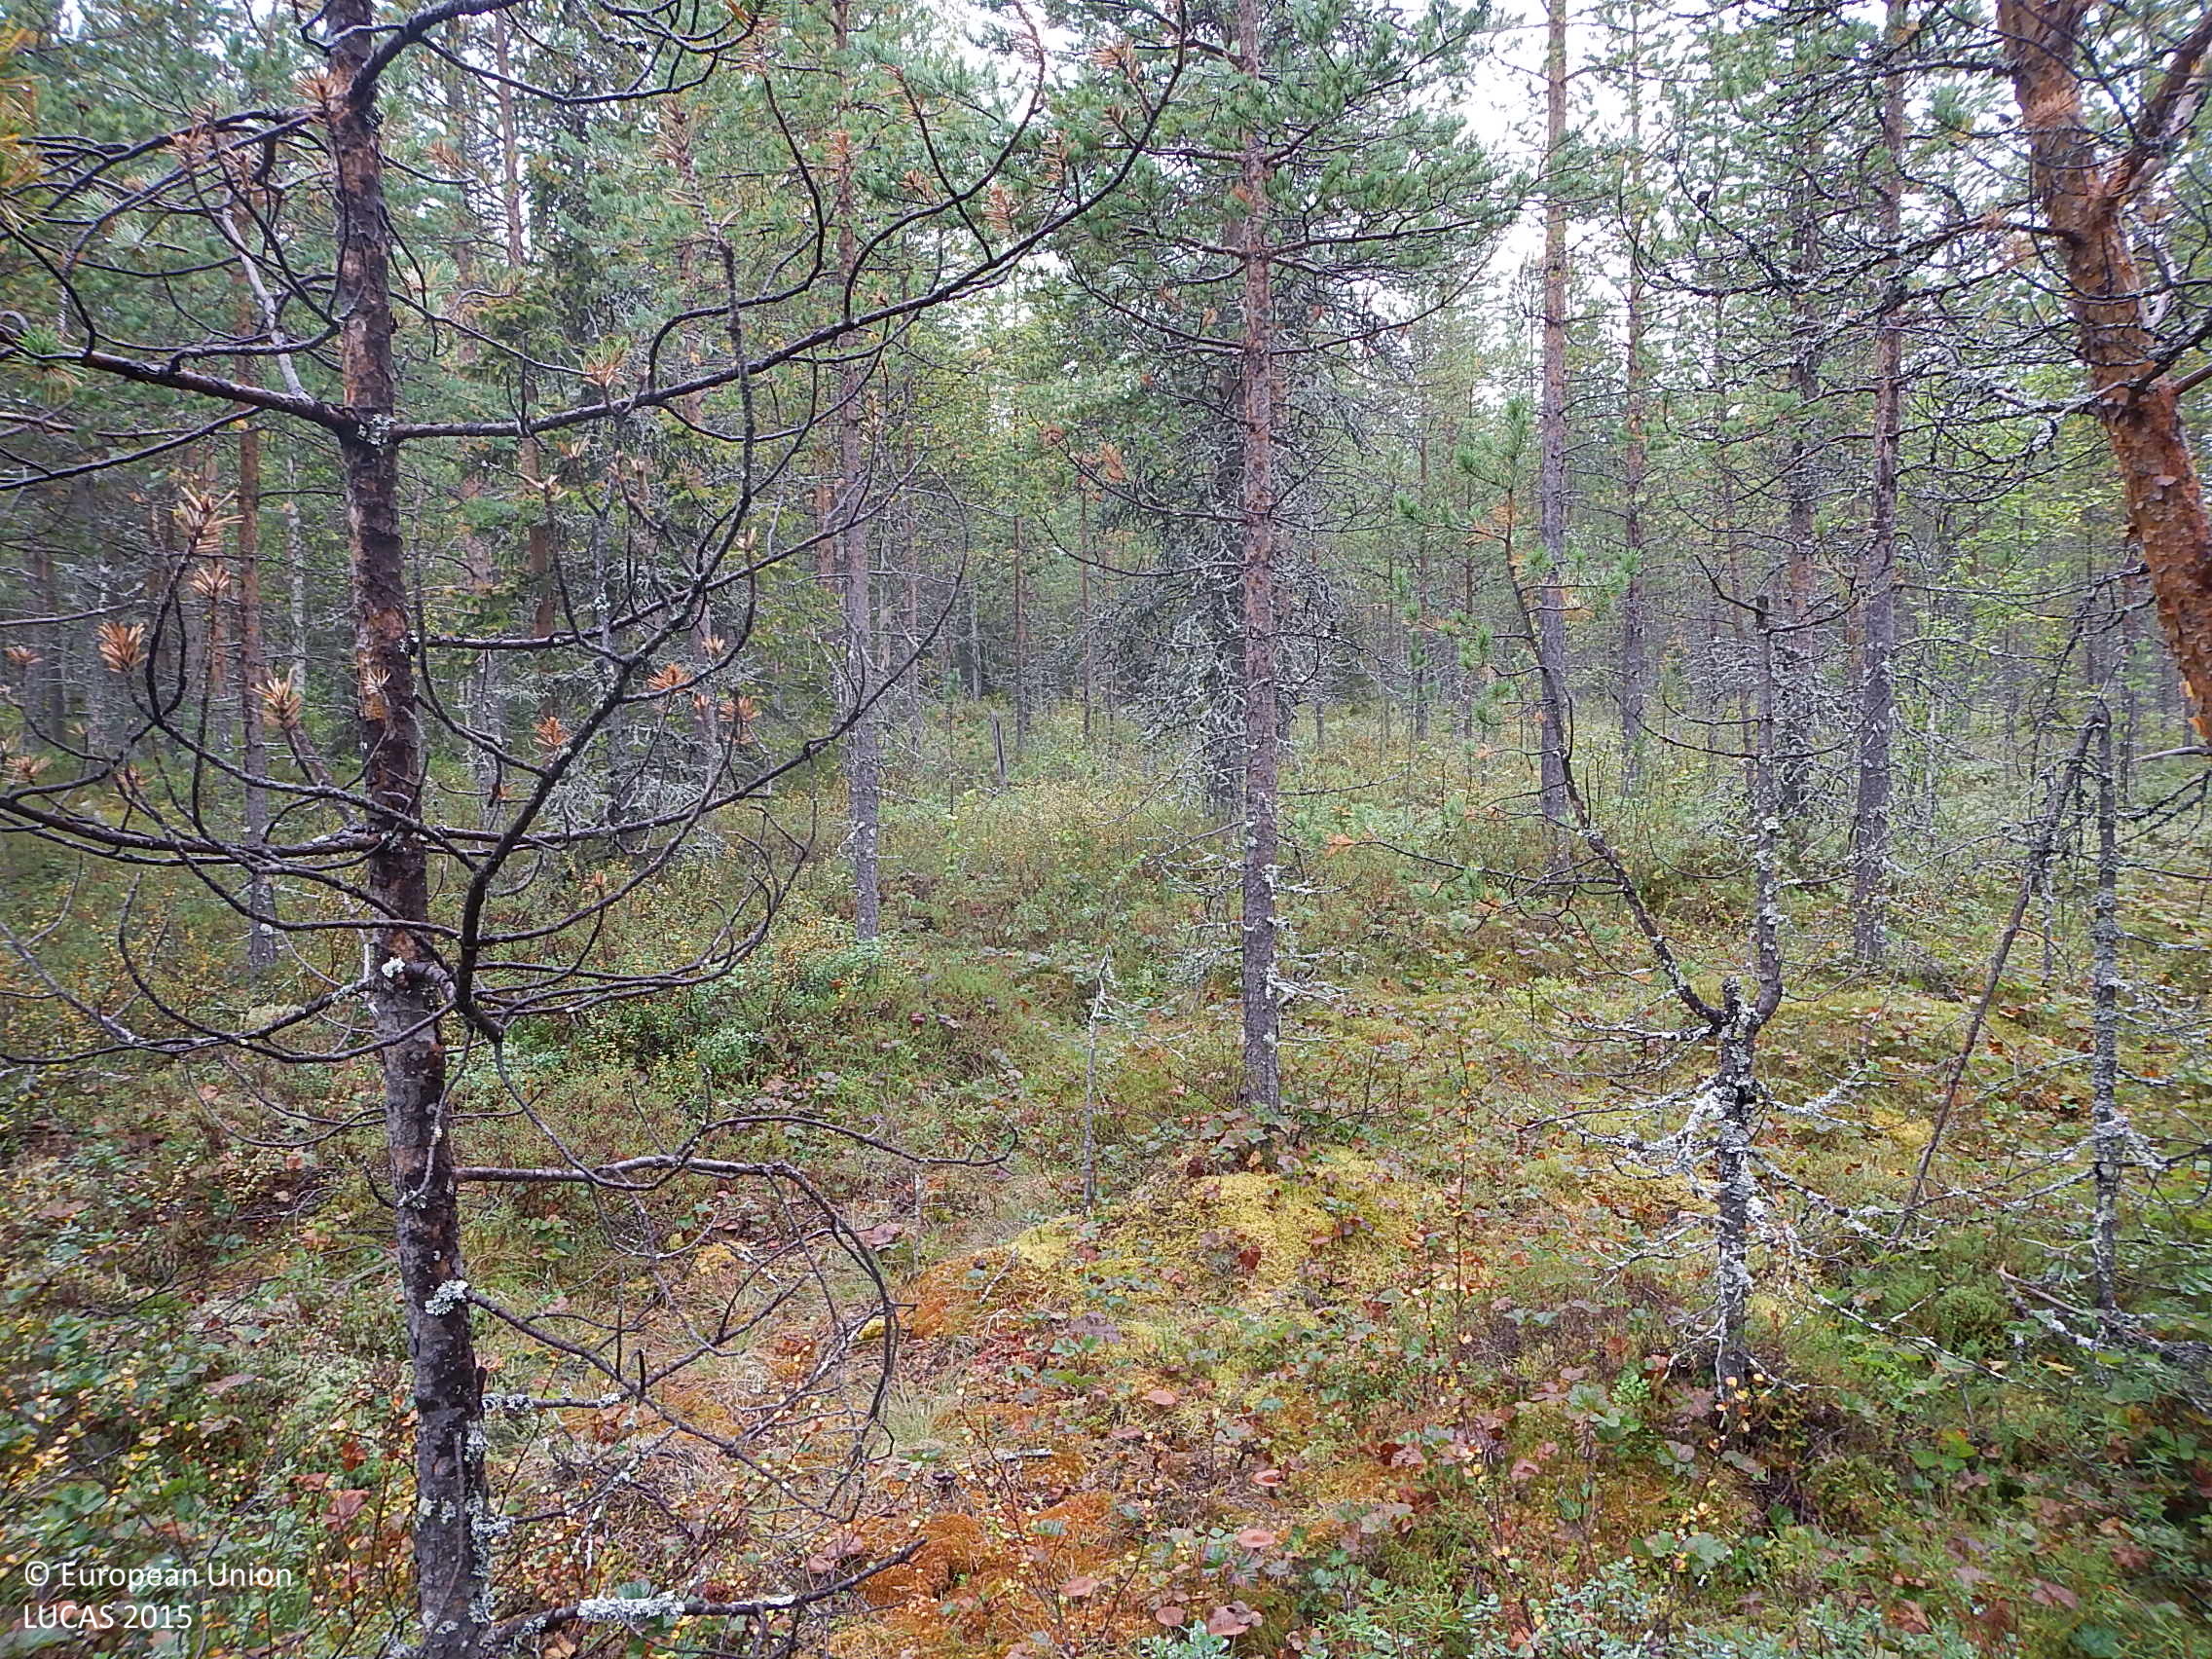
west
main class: Woodland
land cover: Pine dominated coniferous woodland
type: boreal forest
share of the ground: 50 - 75 %
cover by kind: coniferous forest trees 60 %, shrubs 30 %, broadleaved forest trees 5 %, herbaceous plants 5 %
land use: Forestry
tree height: > 5 m
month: August
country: FI
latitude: 65.9633
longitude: 27.3453
